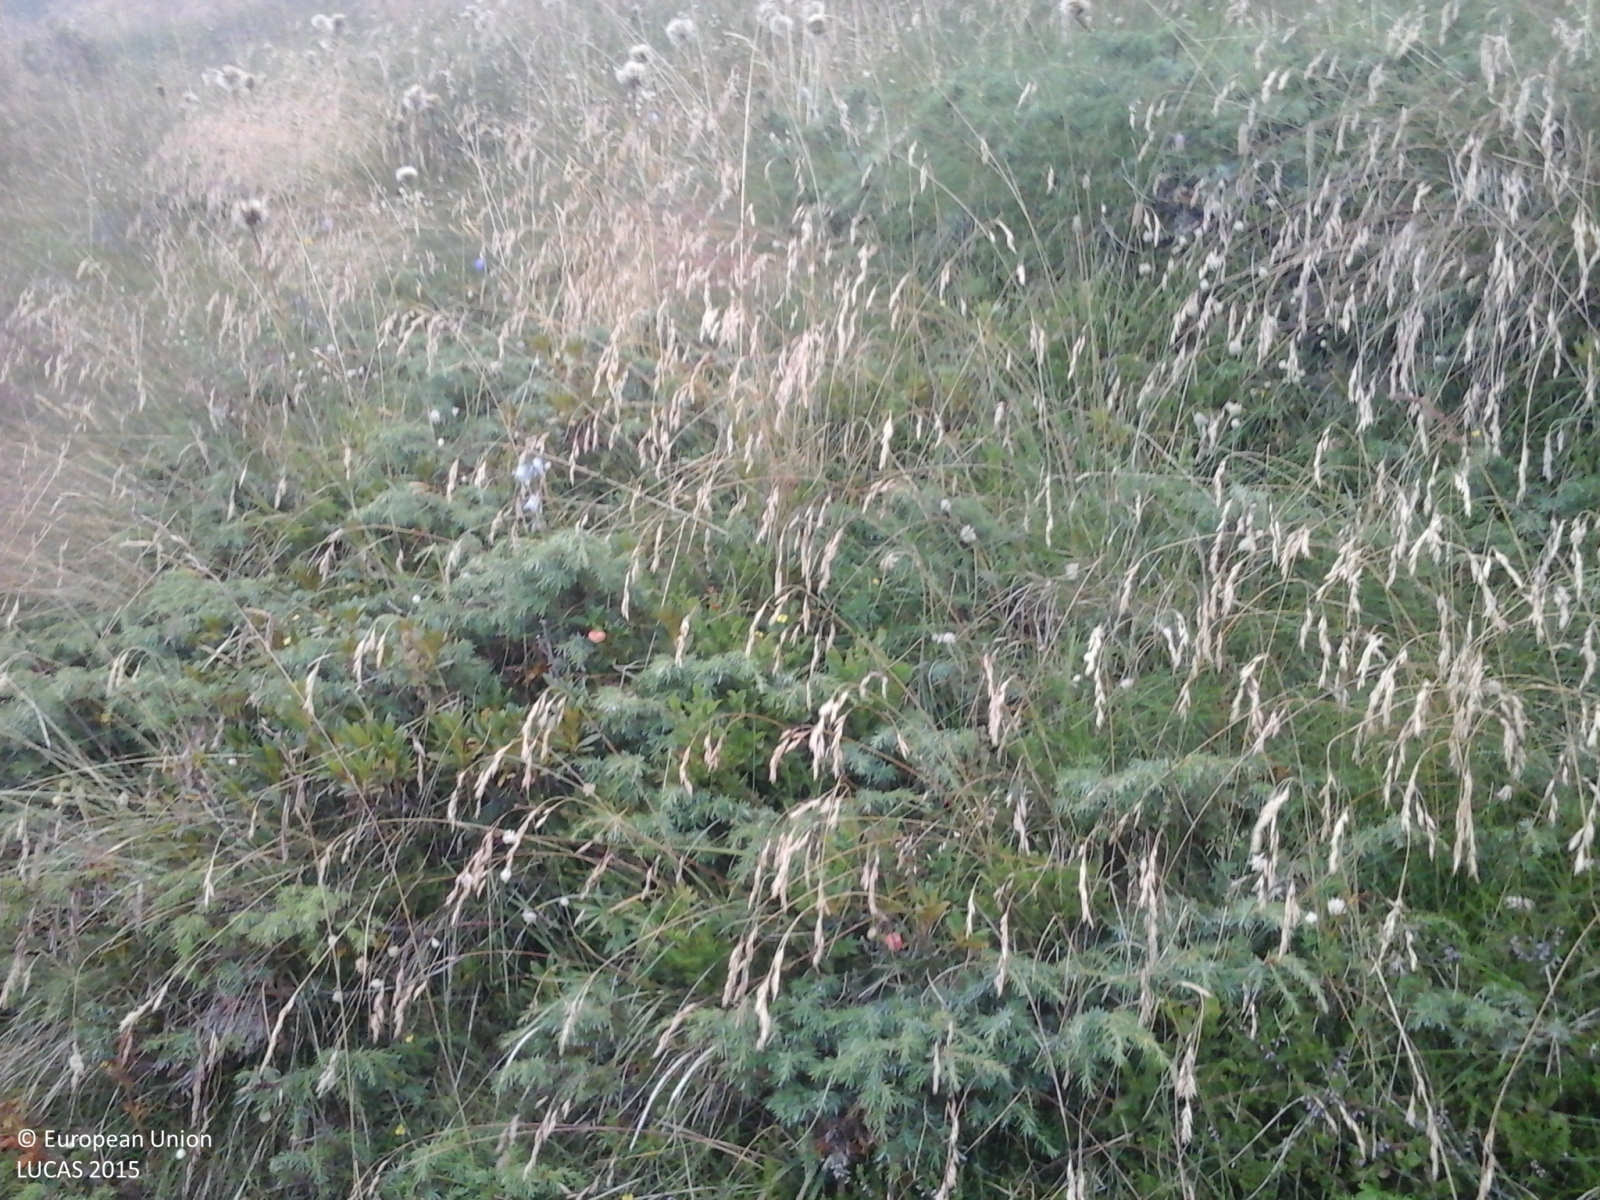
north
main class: Grassland
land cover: Grassland without tree/shrub cover
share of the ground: > 75 %
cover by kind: herbaceous plants 100 %
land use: Agriculture (excluding fallow land and kitchen gardens)
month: July
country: IT
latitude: 46.0443
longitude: 9.6258
